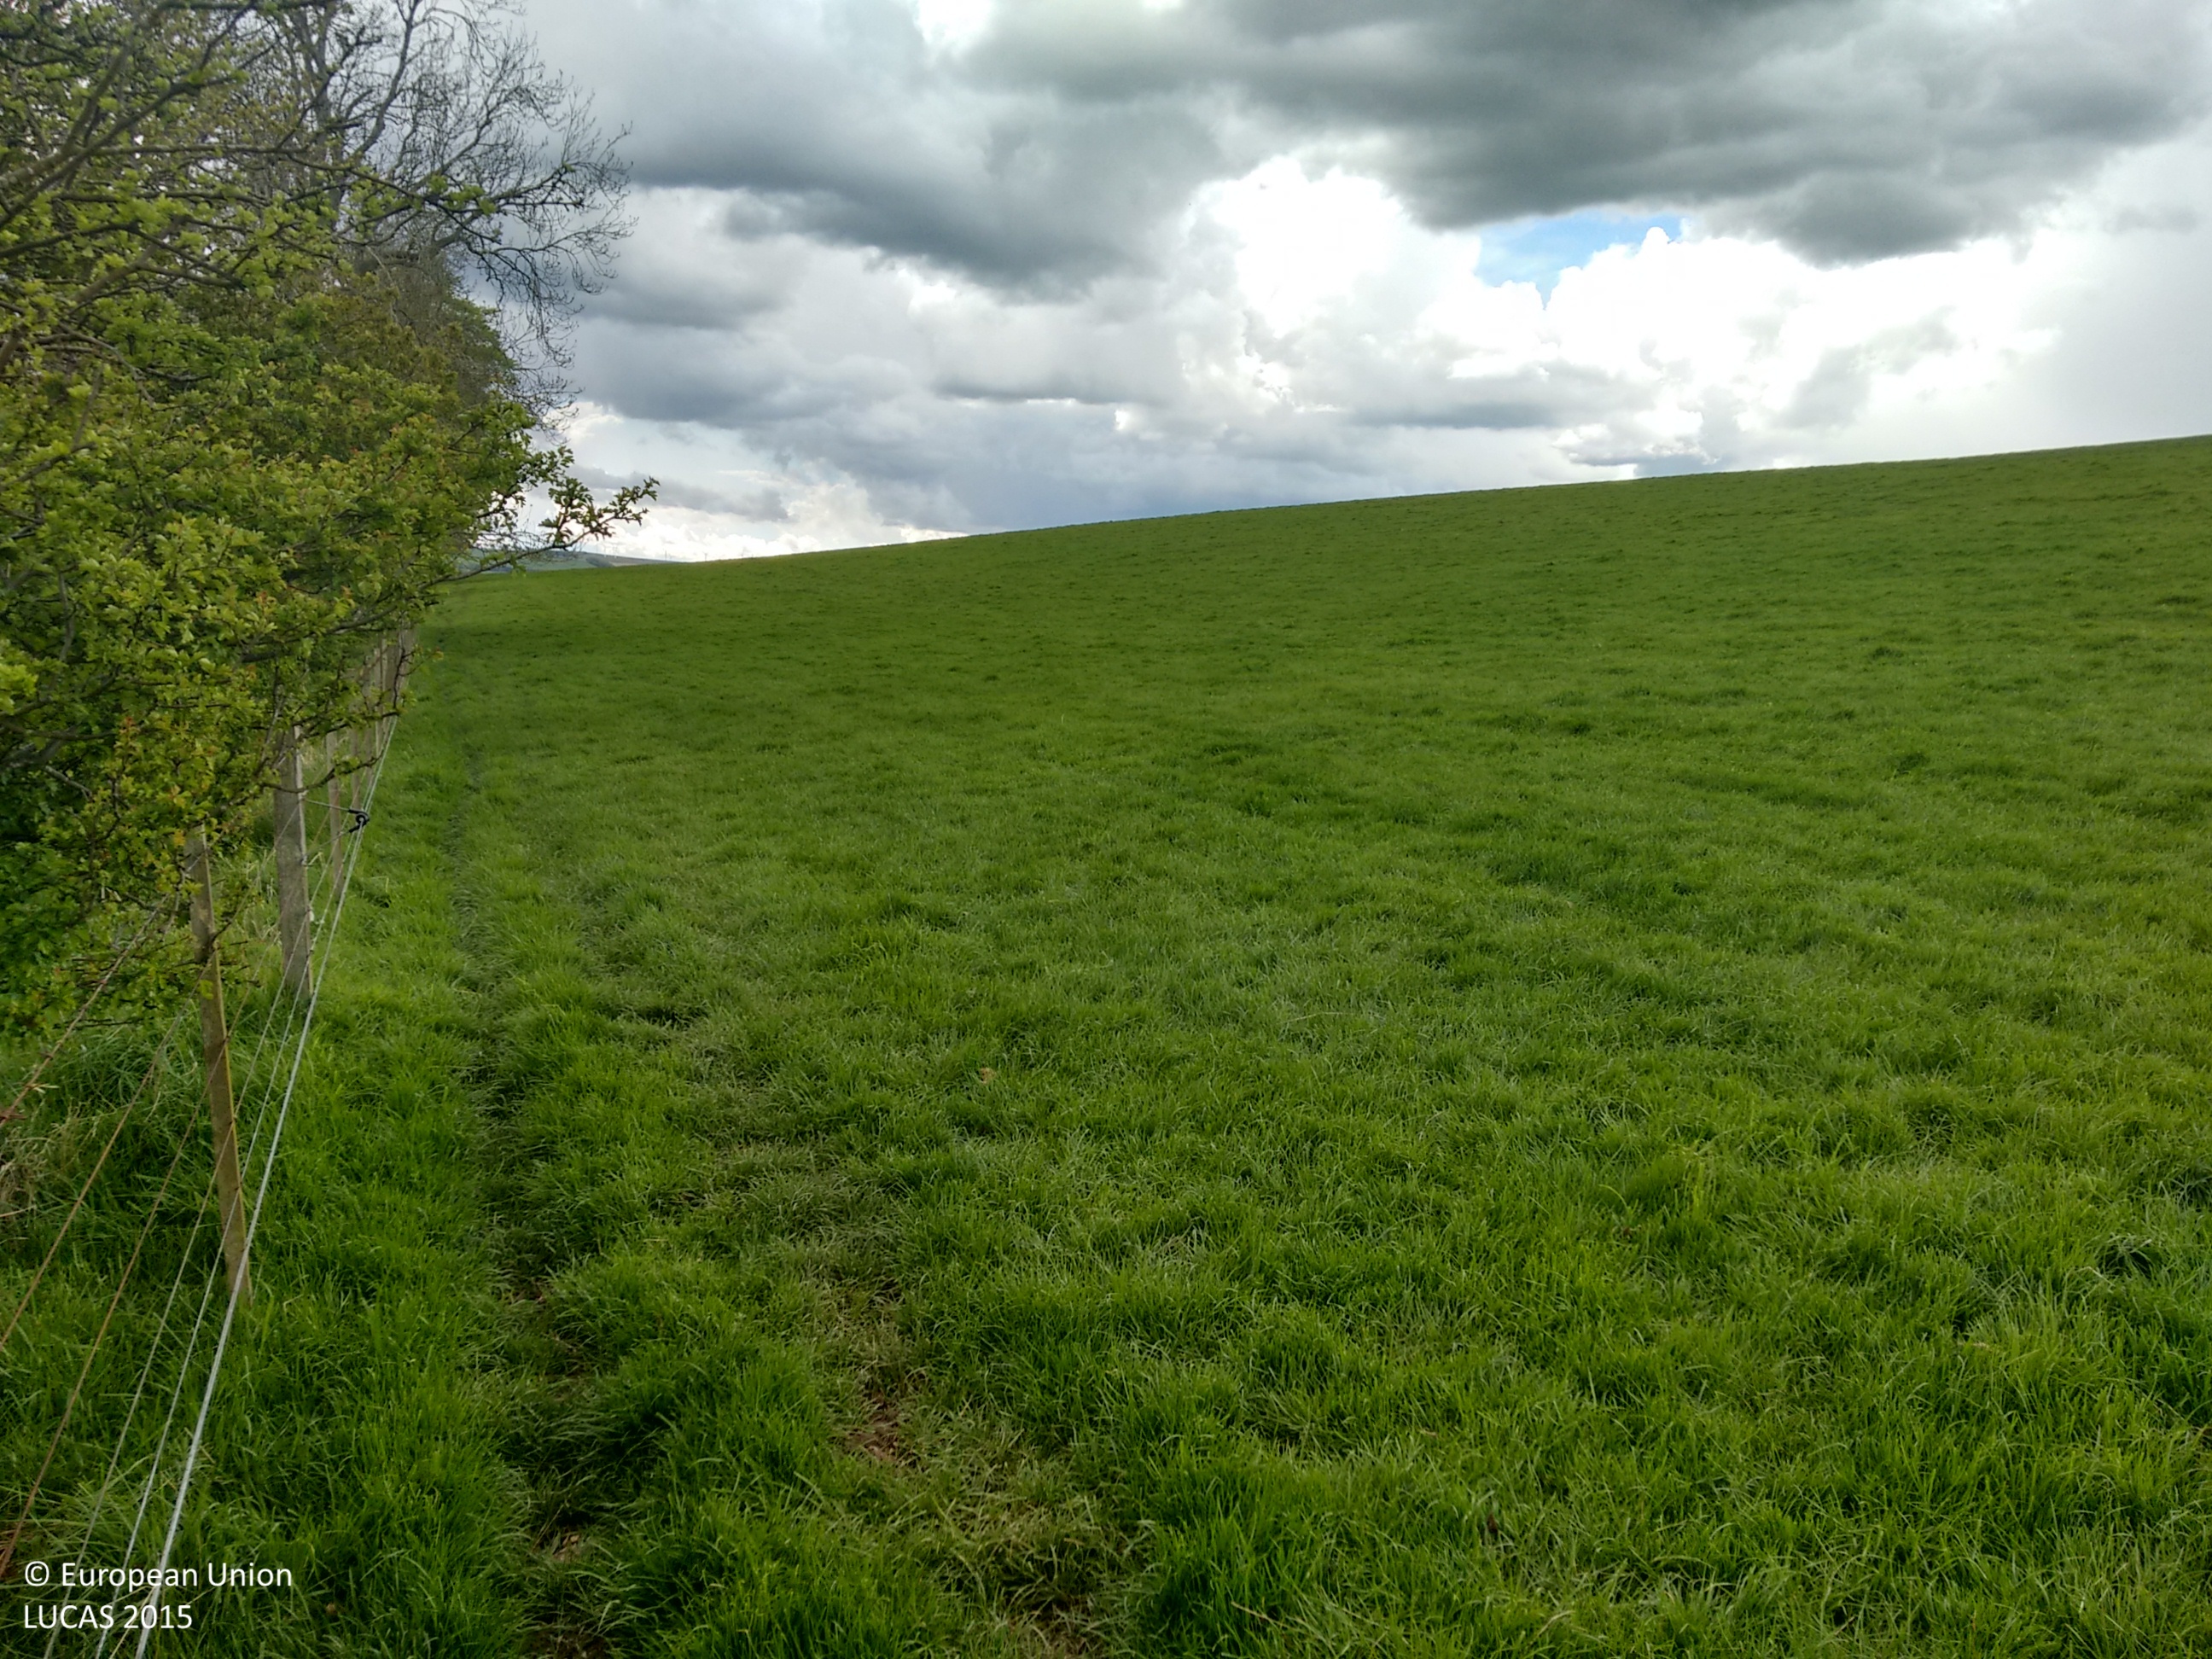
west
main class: Grassland
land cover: Grassland without tree/shrub cover
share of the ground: > 75 %
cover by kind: herbaceous plants 100 %
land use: Agriculture (excluding fallow land and kitchen gardens)
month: May
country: GB
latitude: 55.8122
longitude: -2.2959
